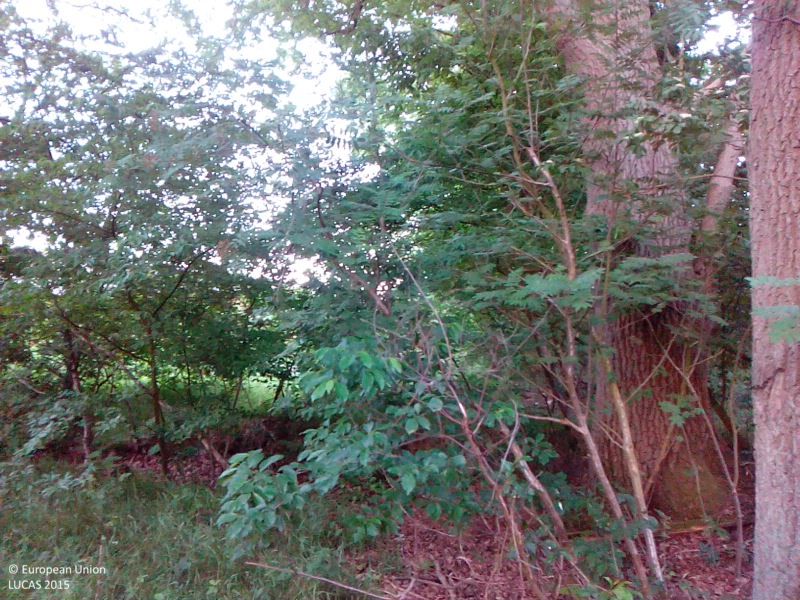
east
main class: Grassland
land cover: Spontaneously vegetated surfaces
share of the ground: > 75 %
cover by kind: herbaceous plants 95 %, shrubs 5 %
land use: Forestry
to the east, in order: Spontaneously vegetated surfaces; Broadleaved woodland; Fences; Tracks; Broadleaved woodland; Grassland without tree/shrub cover; Artificial constructions in urban areas
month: June
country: DE
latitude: 52.5639
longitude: 7.3597
